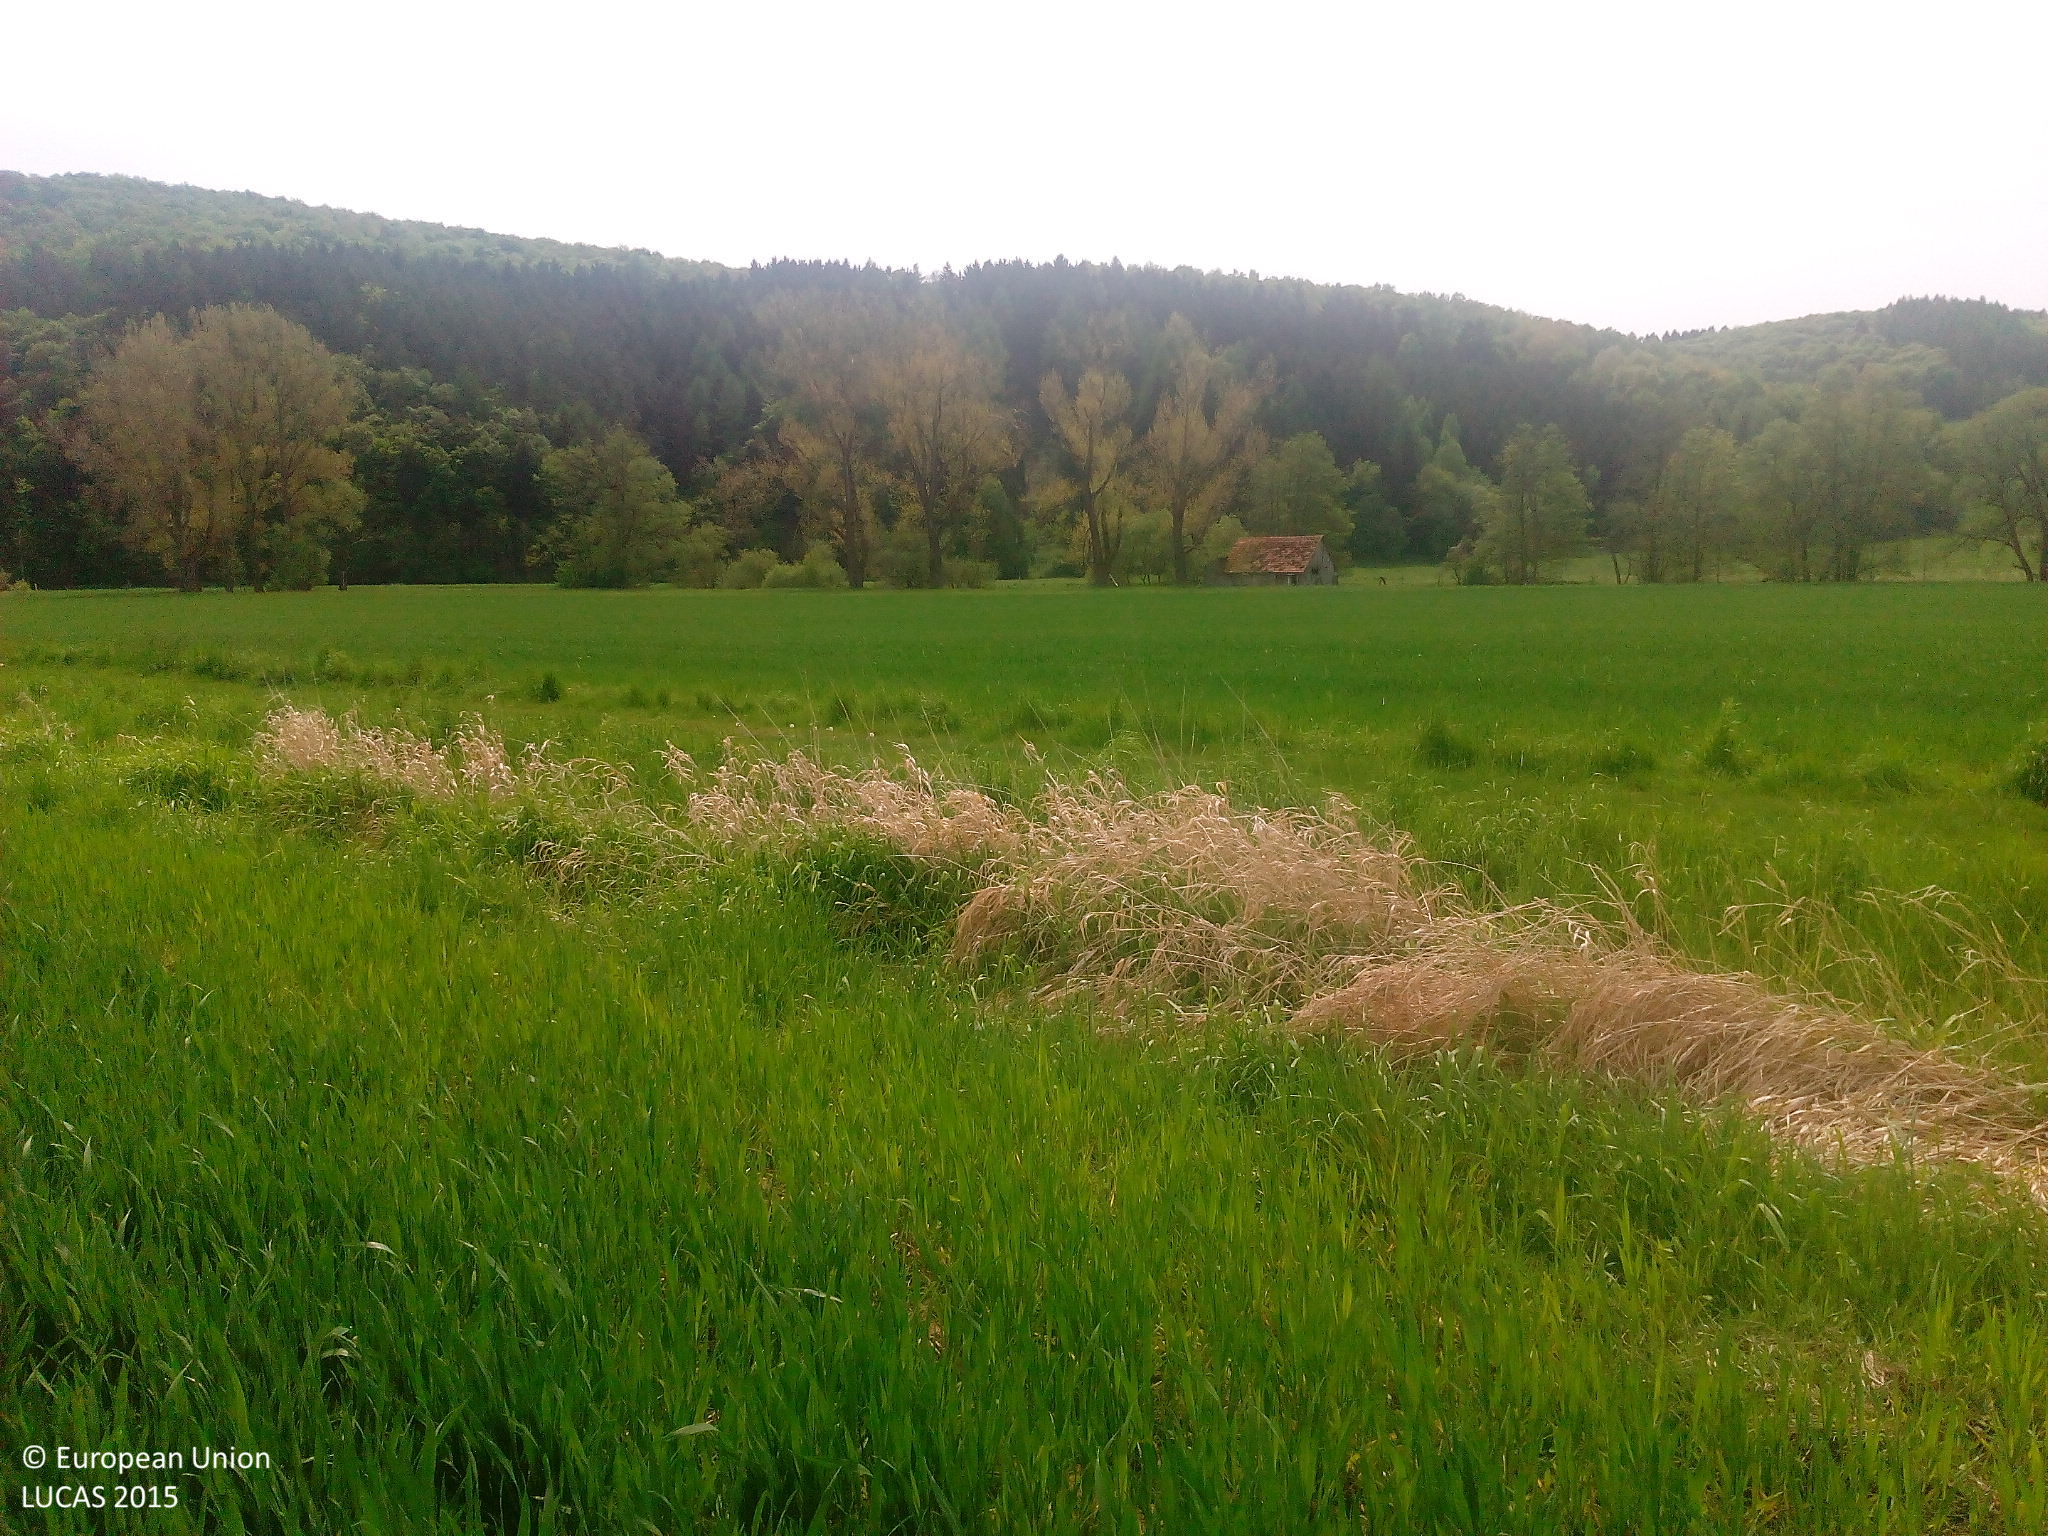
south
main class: Cropland
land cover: Common wheat
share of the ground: > 75 %
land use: Agriculture (excluding fallow land and kitchen gardens)
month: May
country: DE
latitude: 51.1371
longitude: 9.9571
